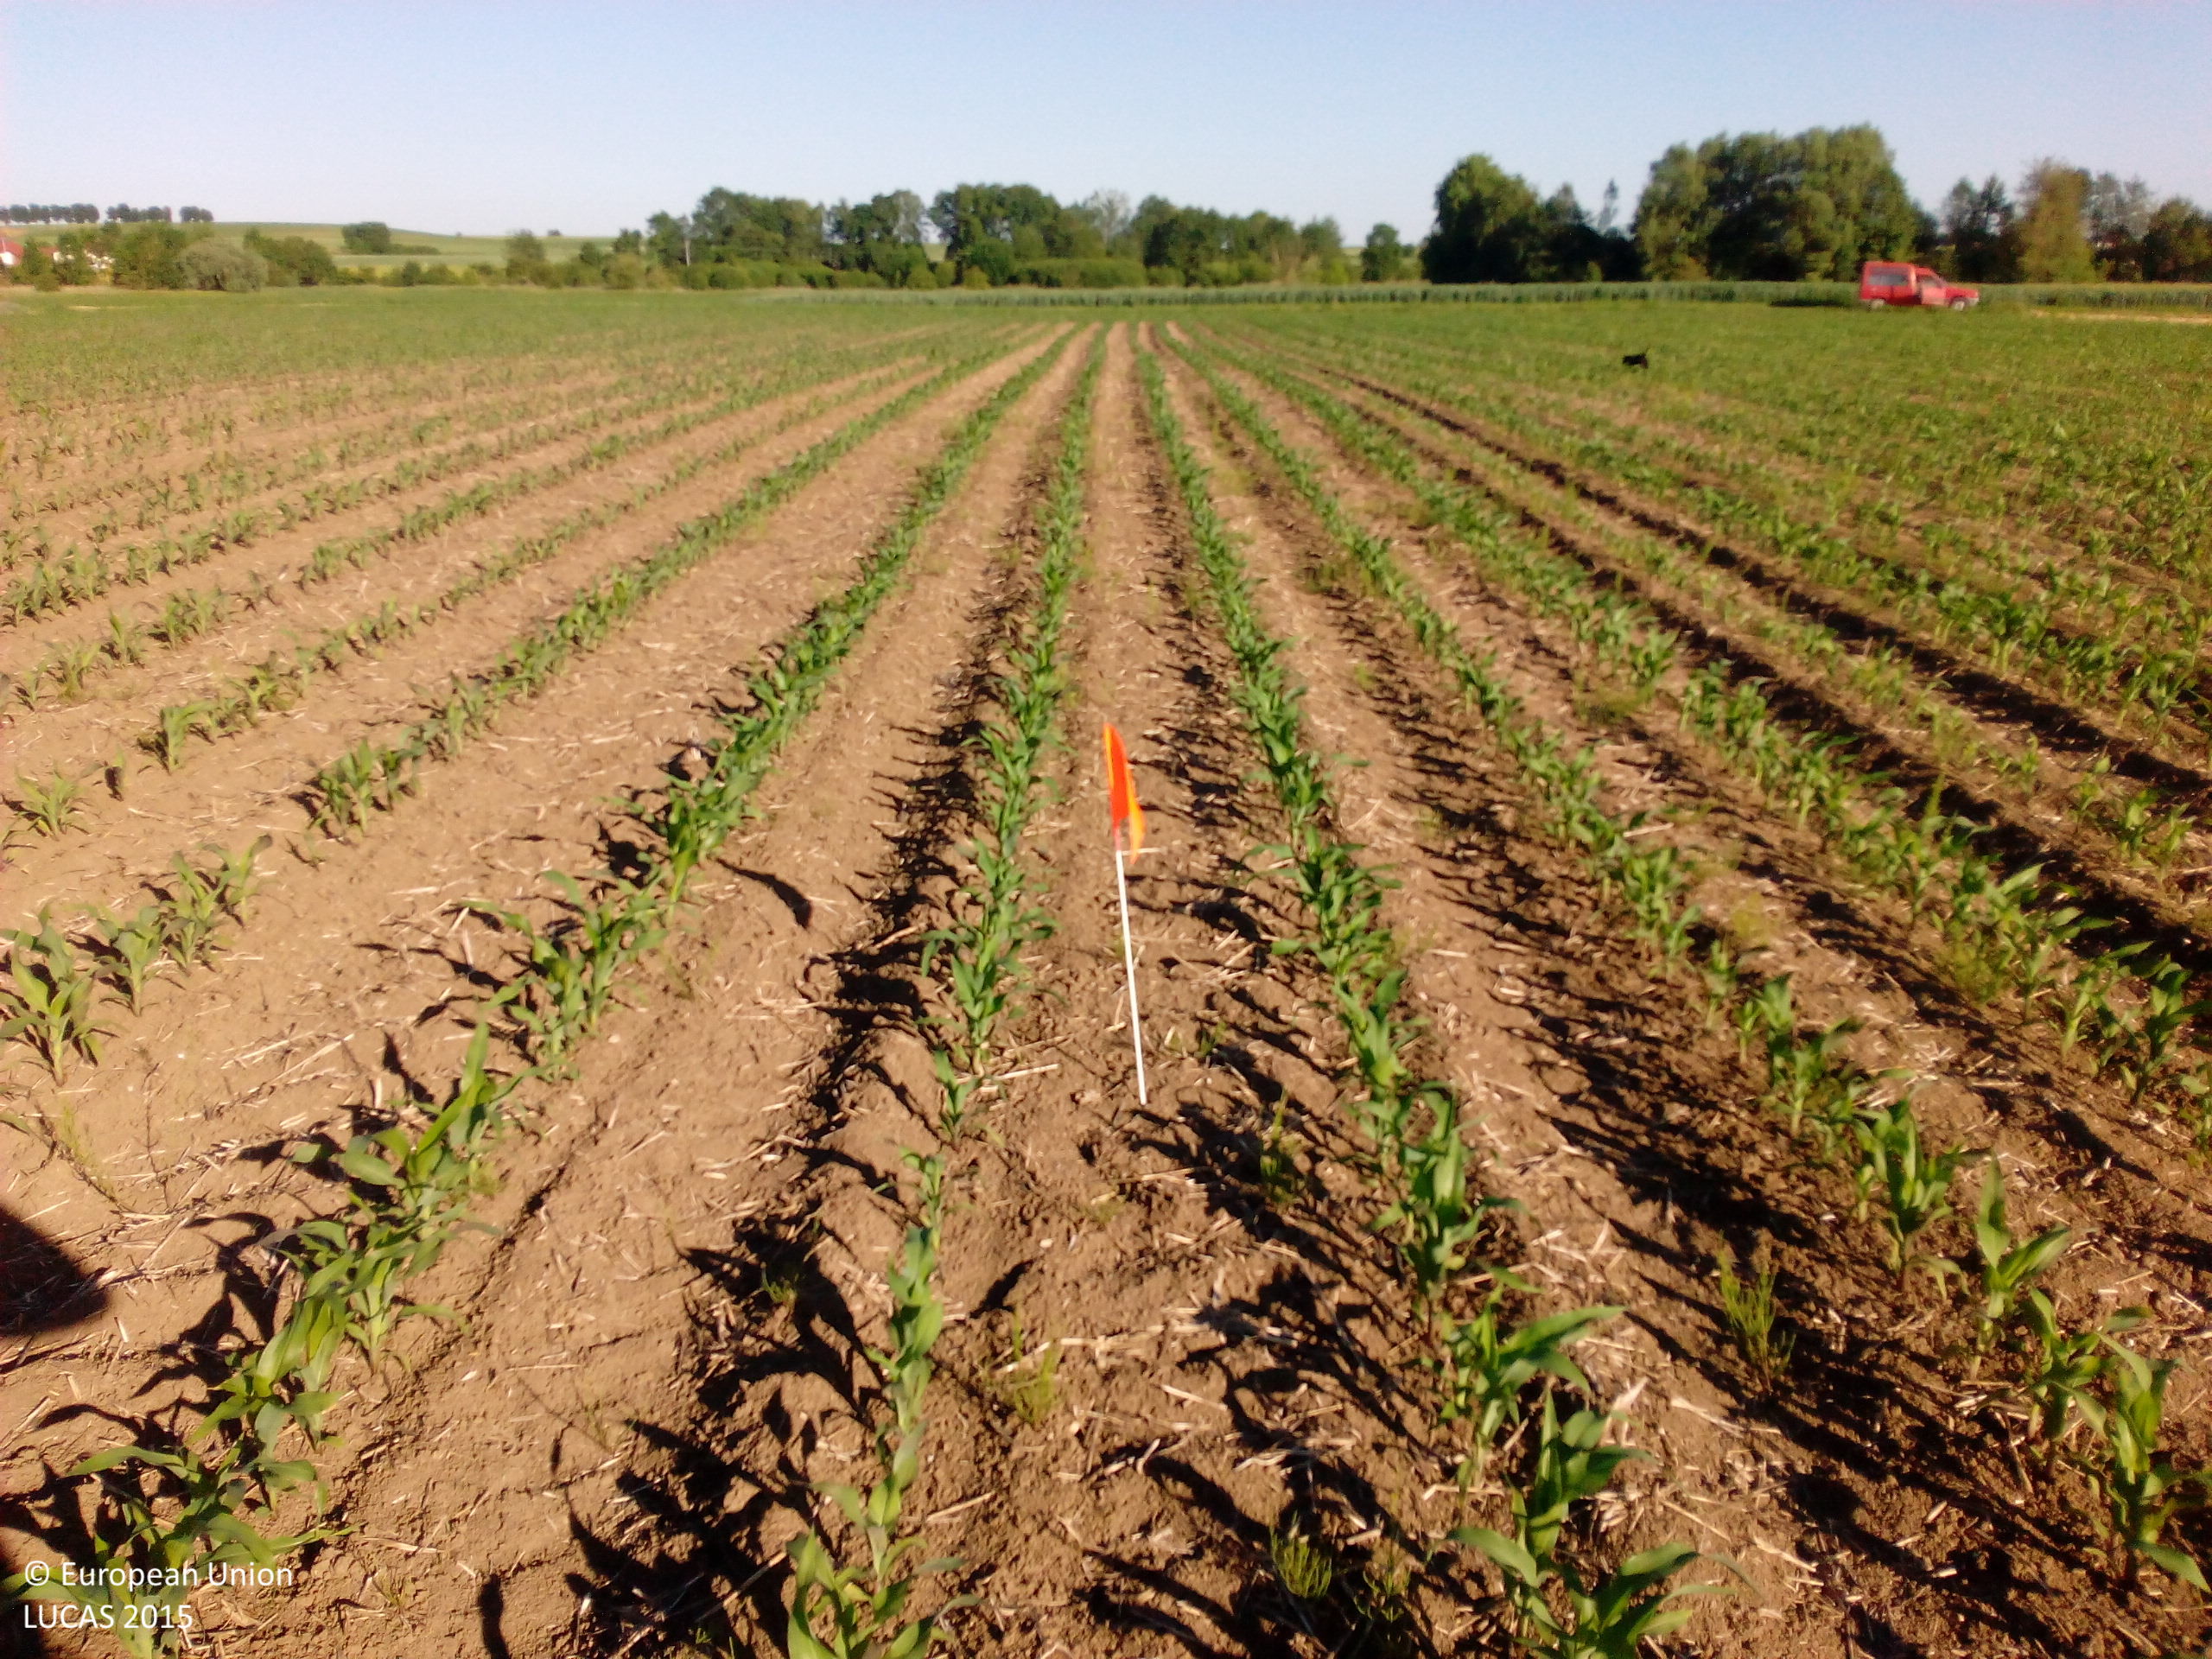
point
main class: Cropland
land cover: Maize
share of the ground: < 10 %
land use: Agriculture (excluding fallow land and kitchen gardens)
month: June
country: DE
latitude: 48.8452
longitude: 12.4112
